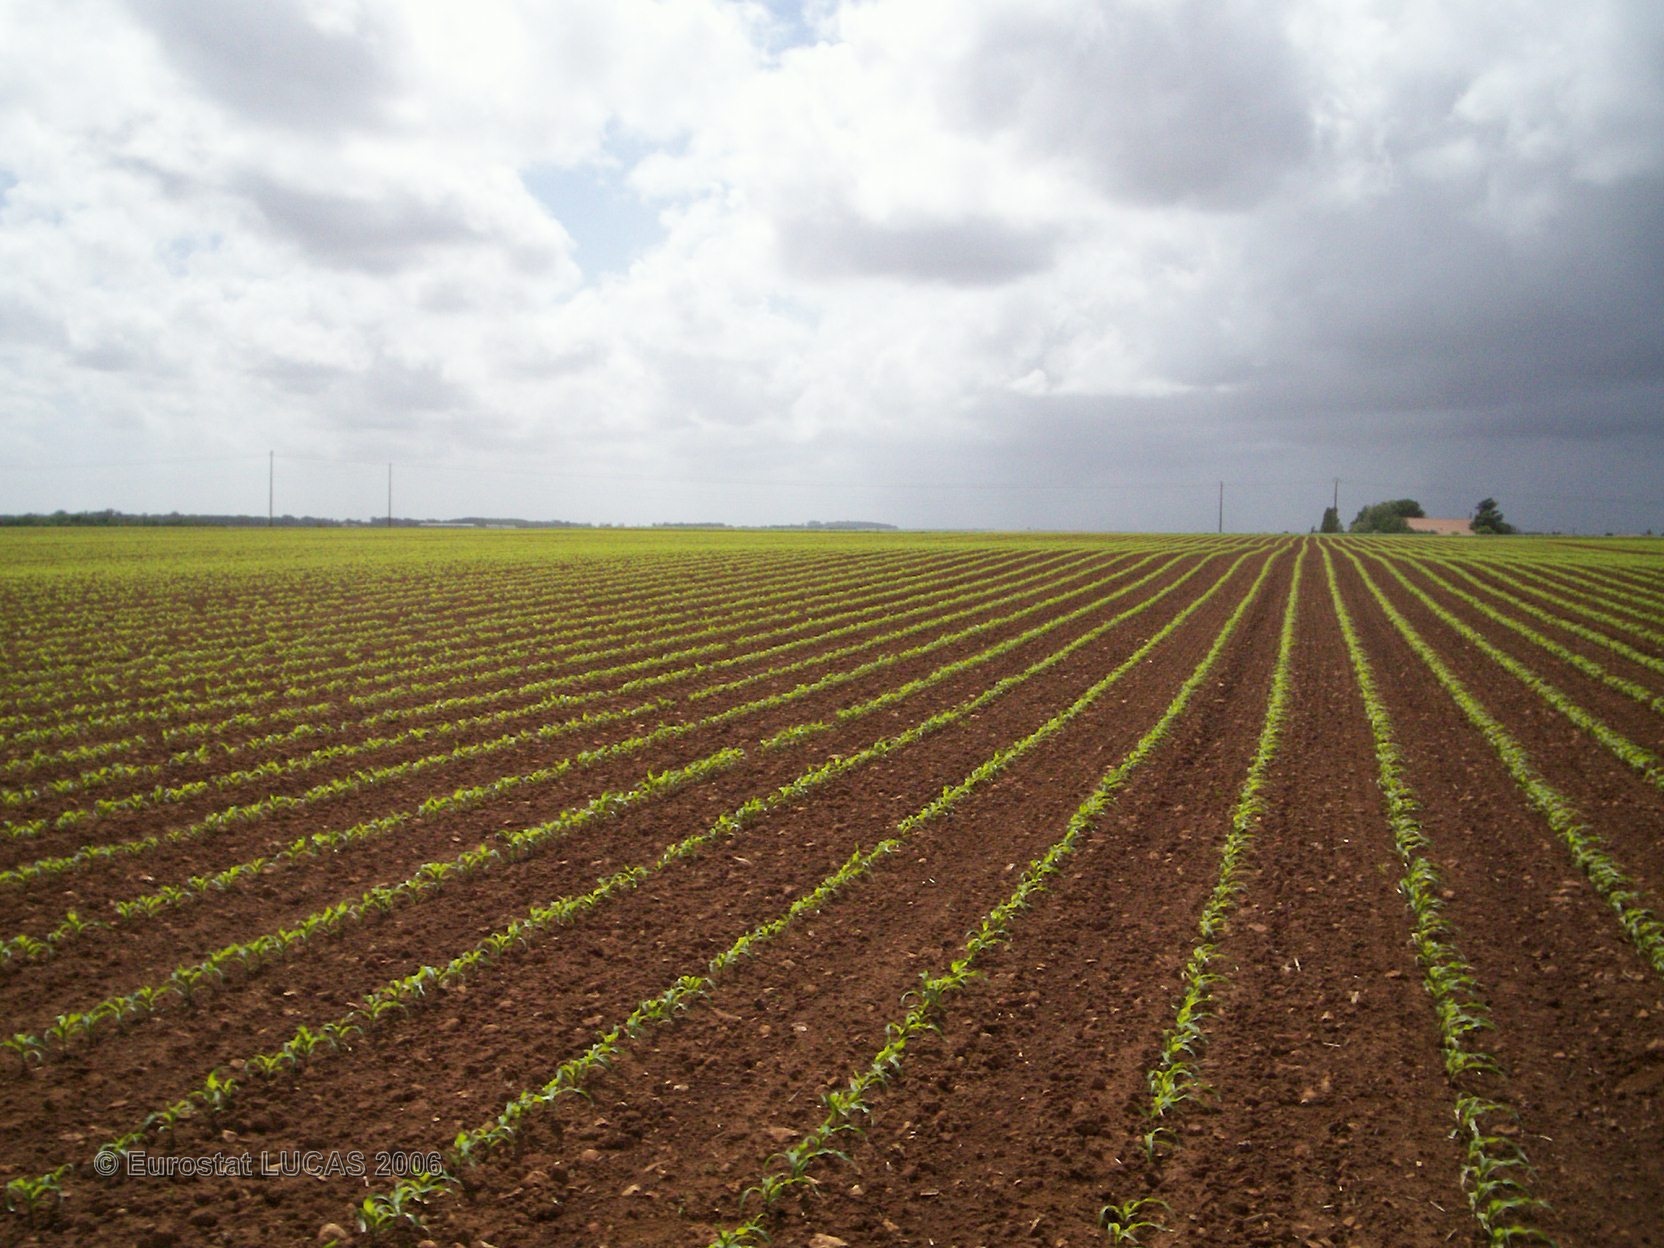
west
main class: Cropland
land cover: Maize
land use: Agriculture (excluding fallow land and kitchen gardens)
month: May
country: FR
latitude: 46.4239
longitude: -0.7639
